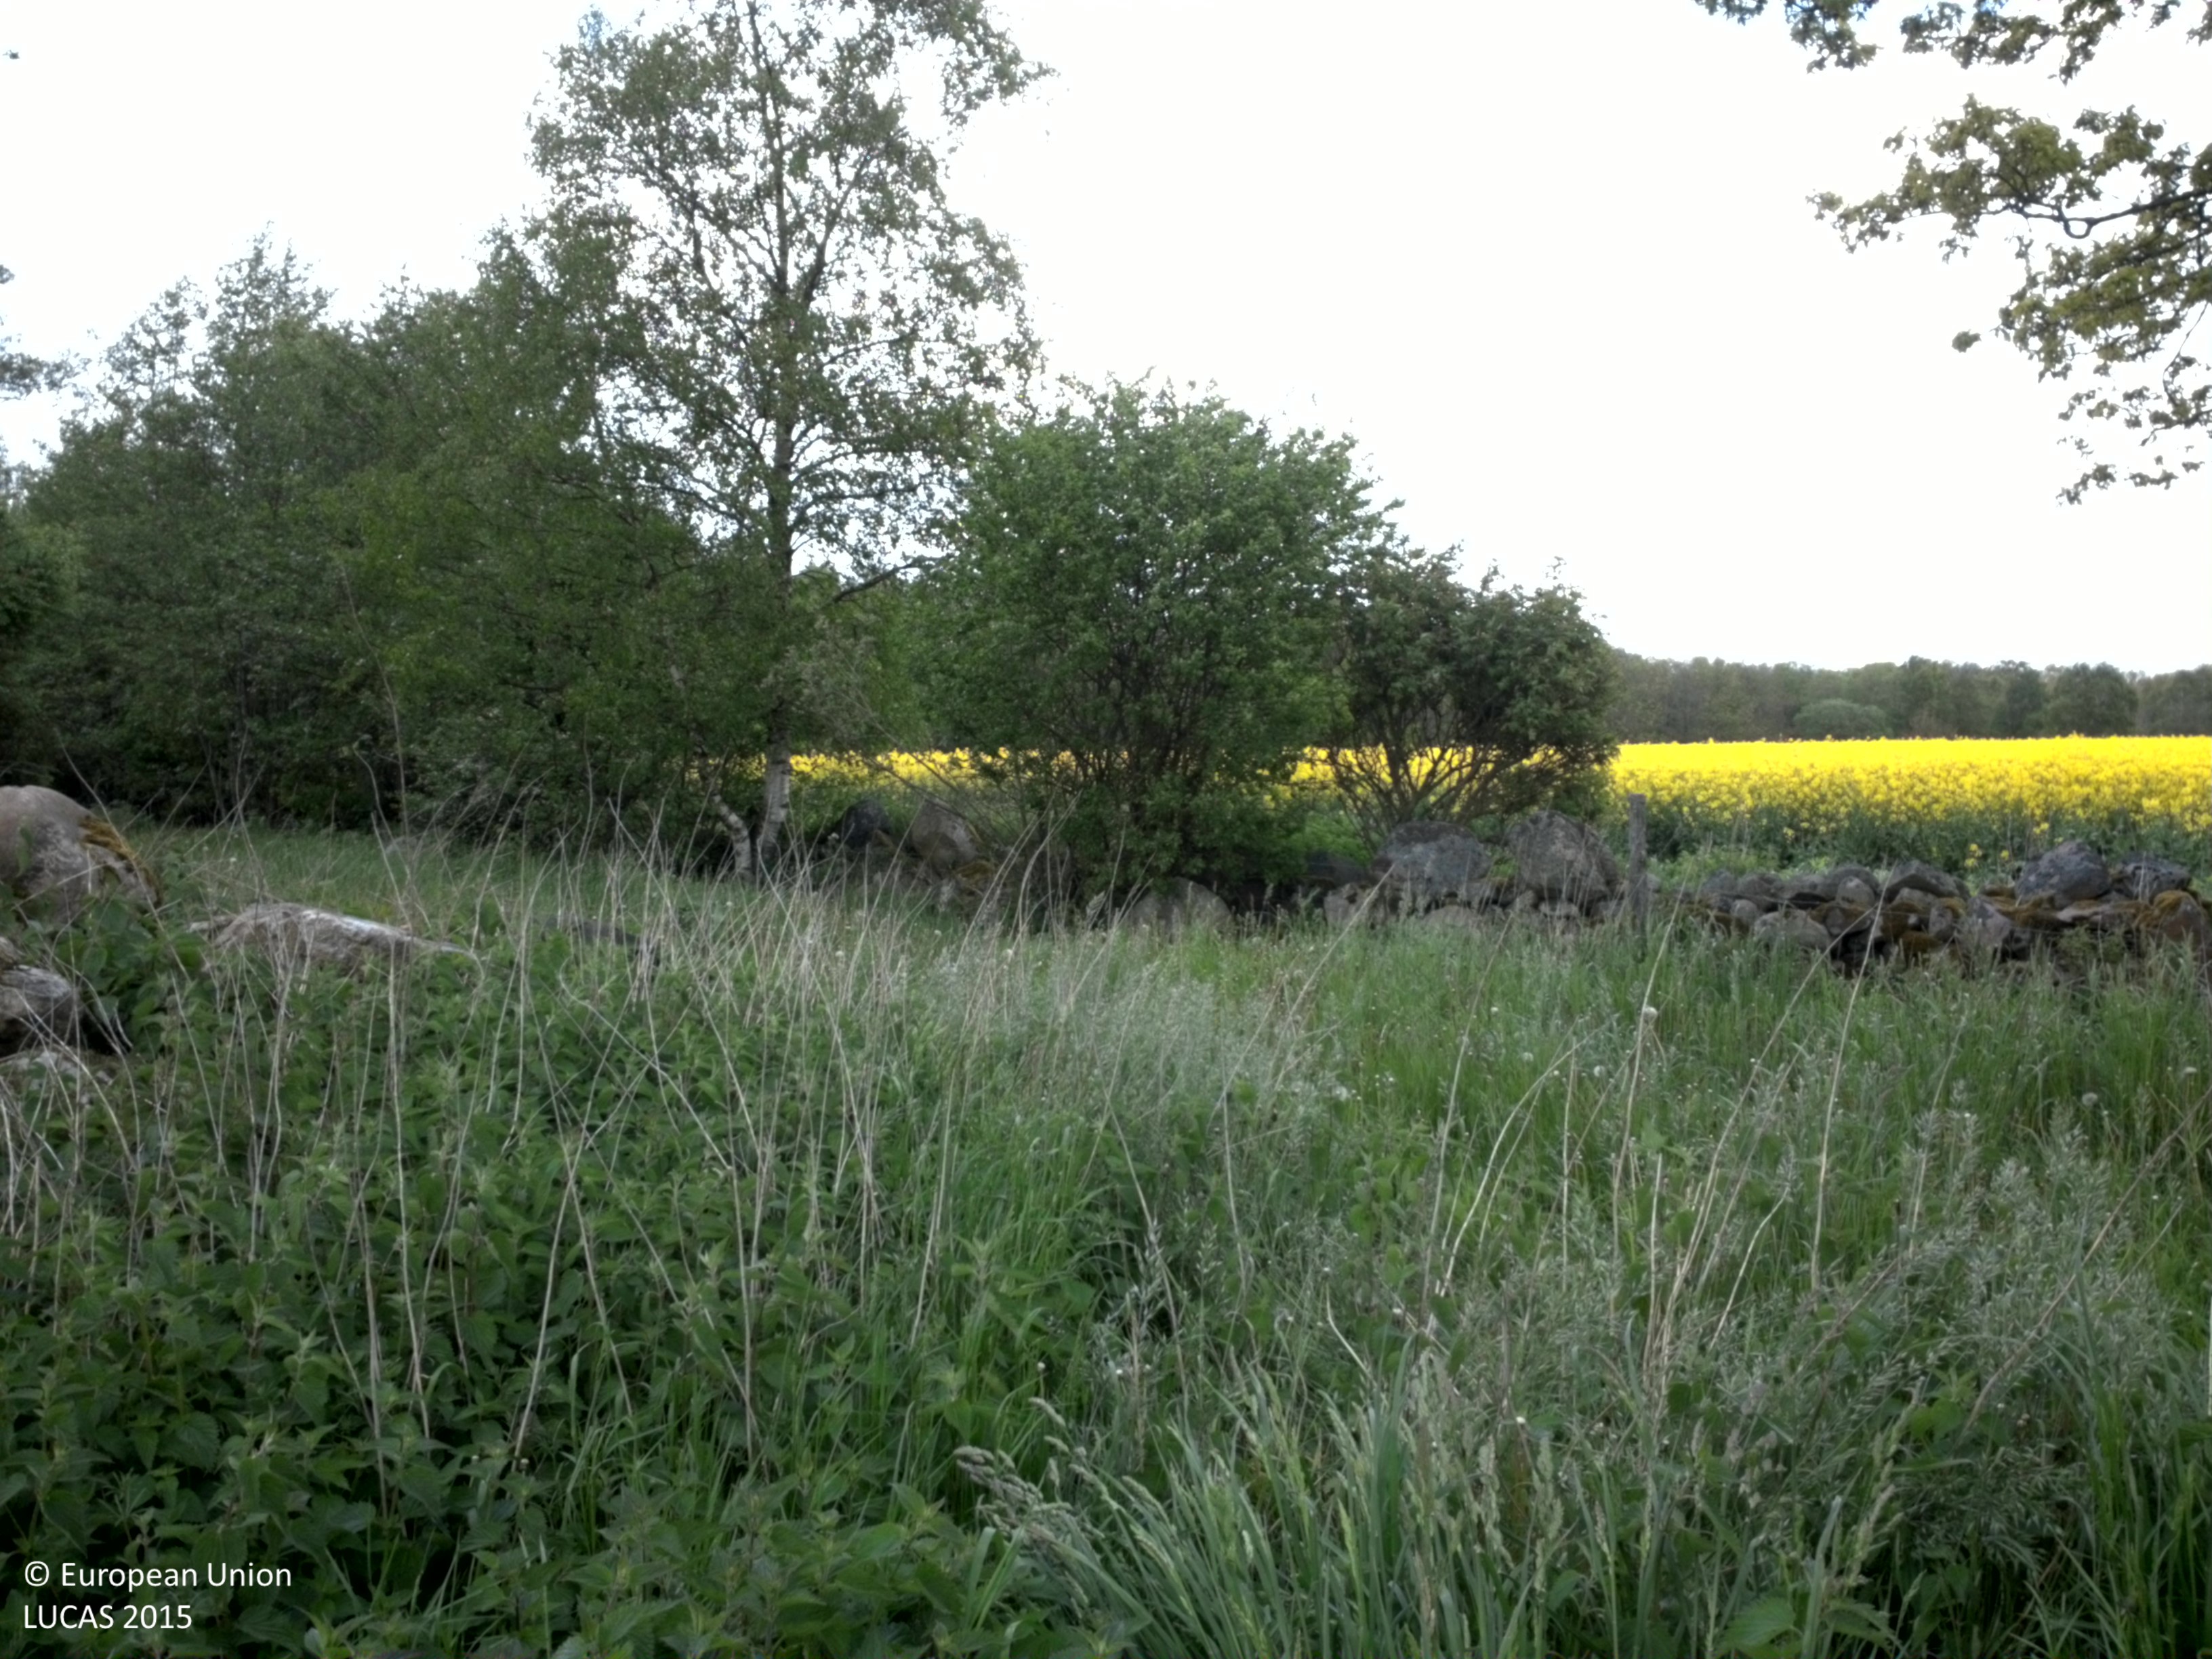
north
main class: Grassland
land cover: Grassland with sparse tree/shrub cover
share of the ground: > 75 %
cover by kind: herbaceous plants 95 %, broadleaved forest trees 5 %
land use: Agriculture (excluding fallow land and kitchen gardens)
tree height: > 5 m
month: June
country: SE
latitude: 55.8469
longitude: 13.6873
